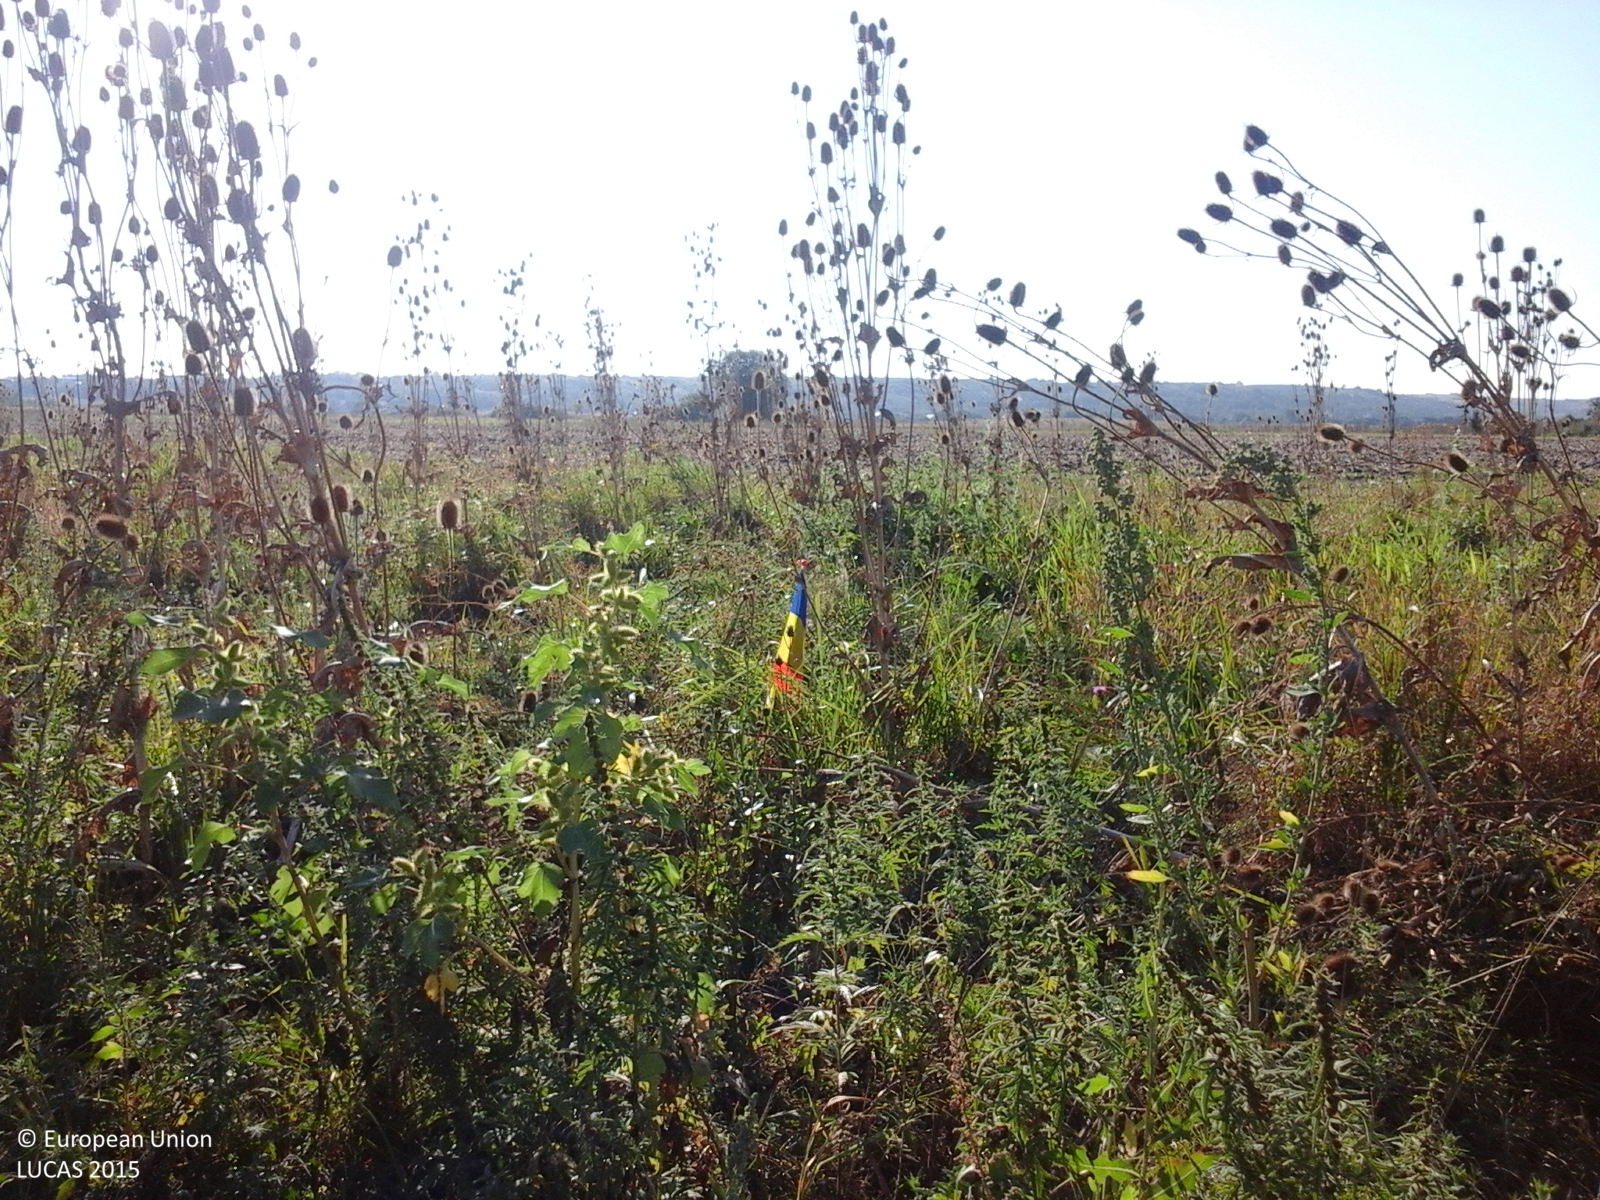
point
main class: Grassland
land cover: Spontaneously vegetated surfaces
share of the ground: > 75 %
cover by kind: herbaceous plants 100 %
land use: Fallow land
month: September
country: RO
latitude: 47.5607
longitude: 22.8348
